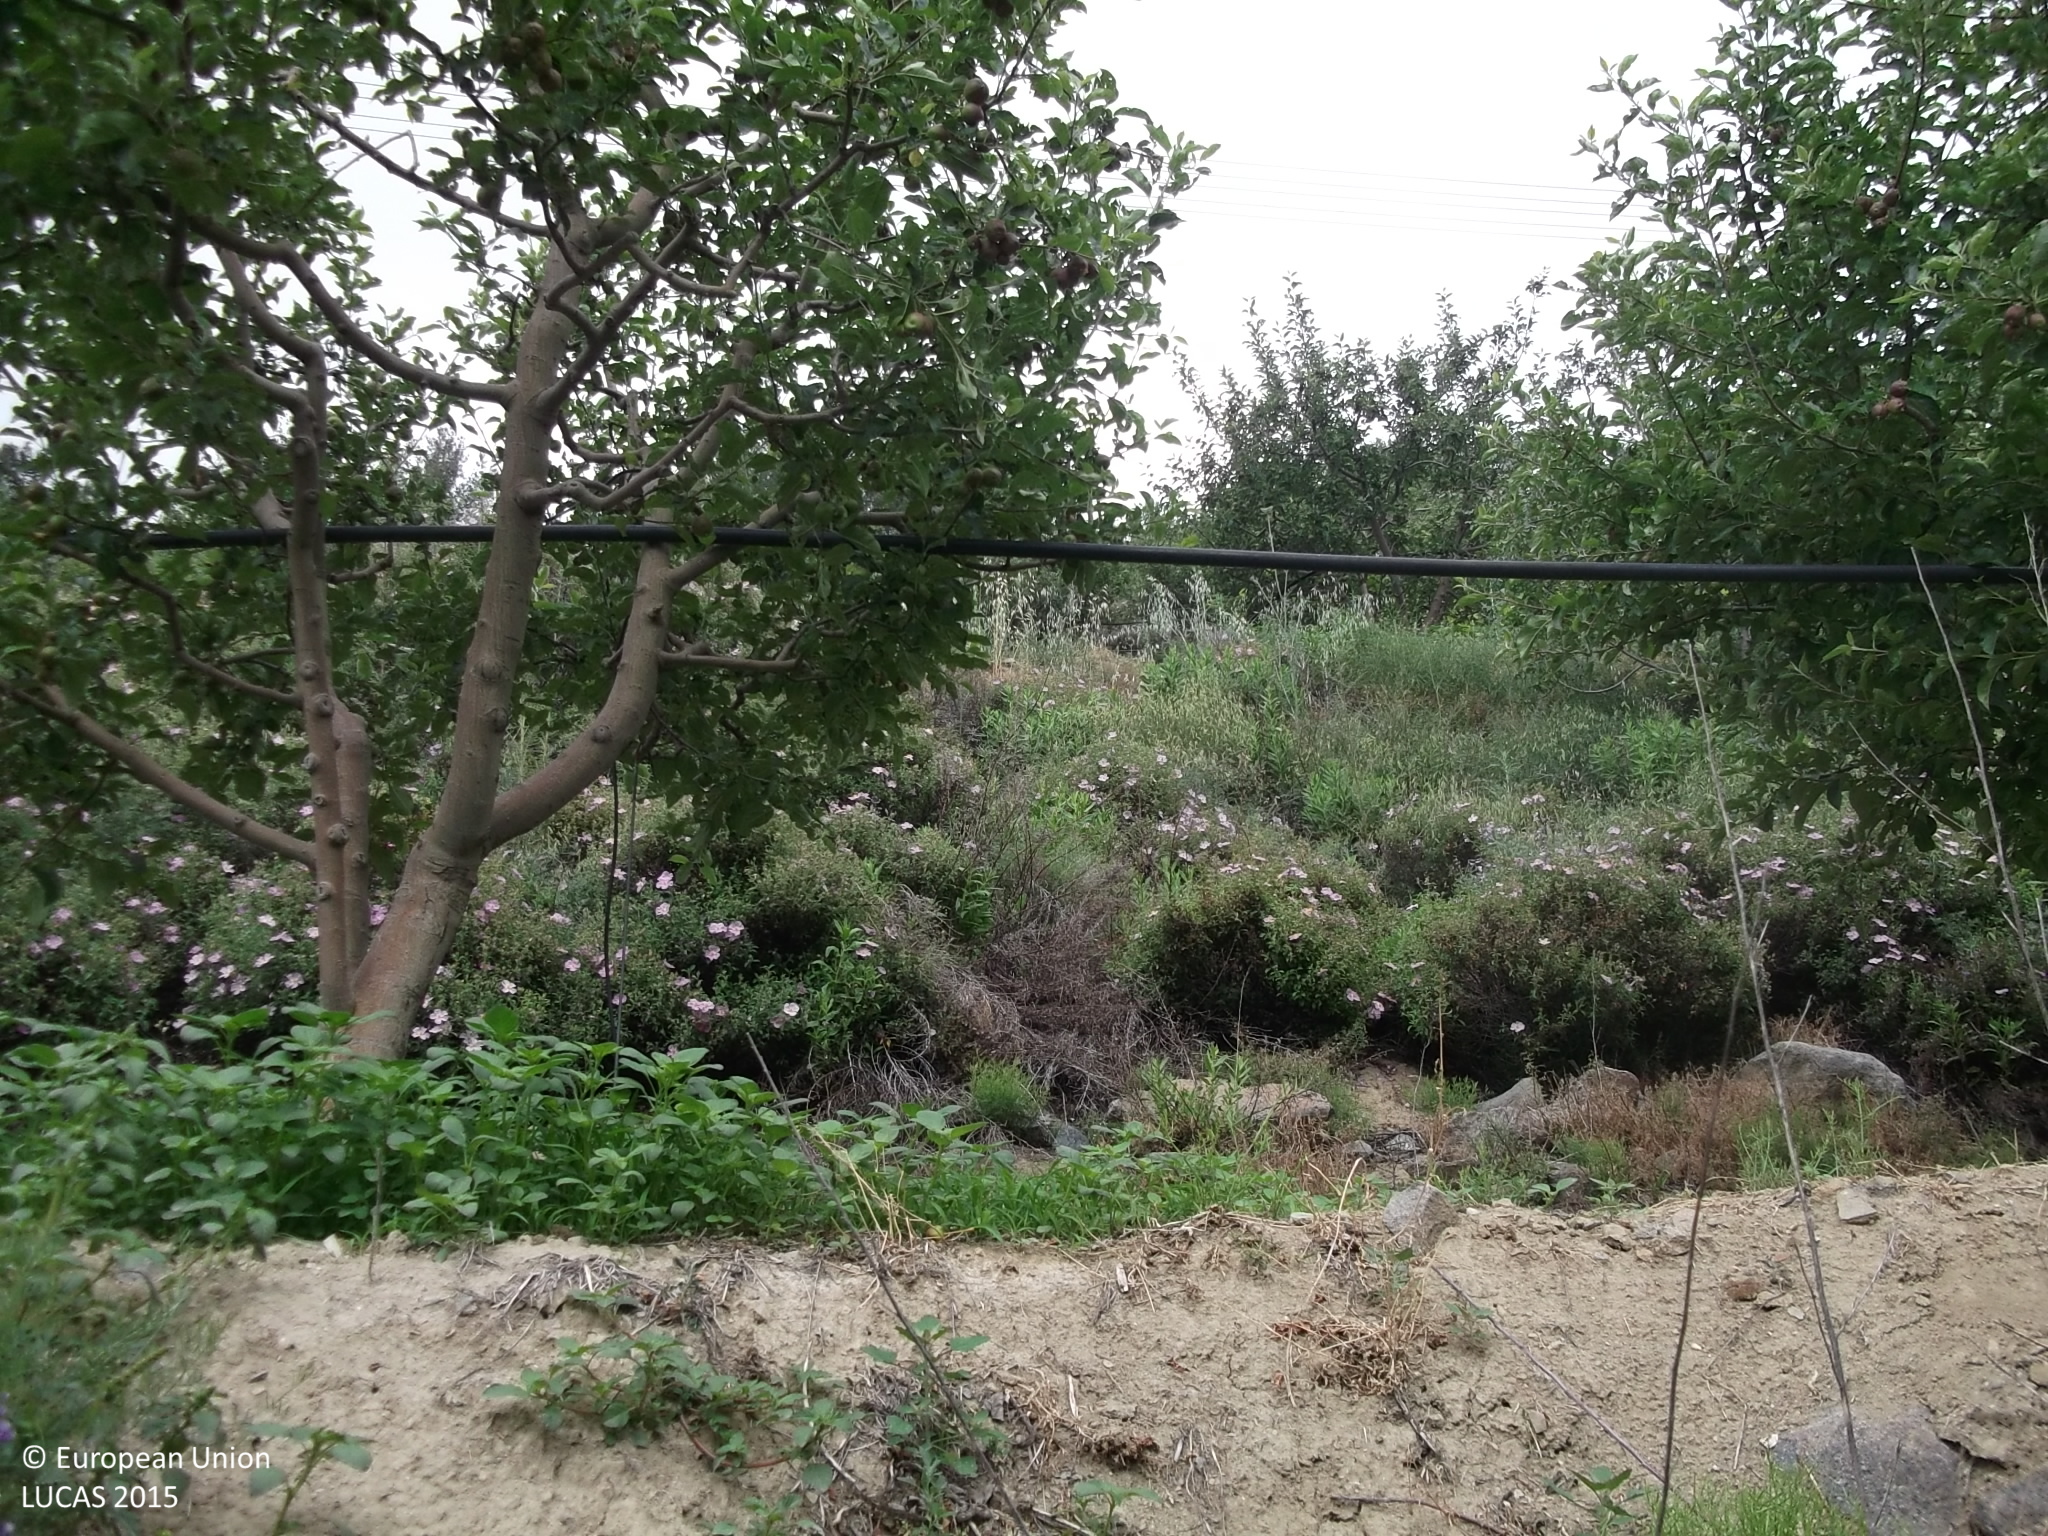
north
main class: Cropland
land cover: Apple fruit
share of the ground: > 75 %
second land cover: Grassland without tree/shrub cover
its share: 25 - 50 %
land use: Agriculture (excluding fallow land and kitchen gardens)
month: June
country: CY
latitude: 34.9371
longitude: 32.9535
